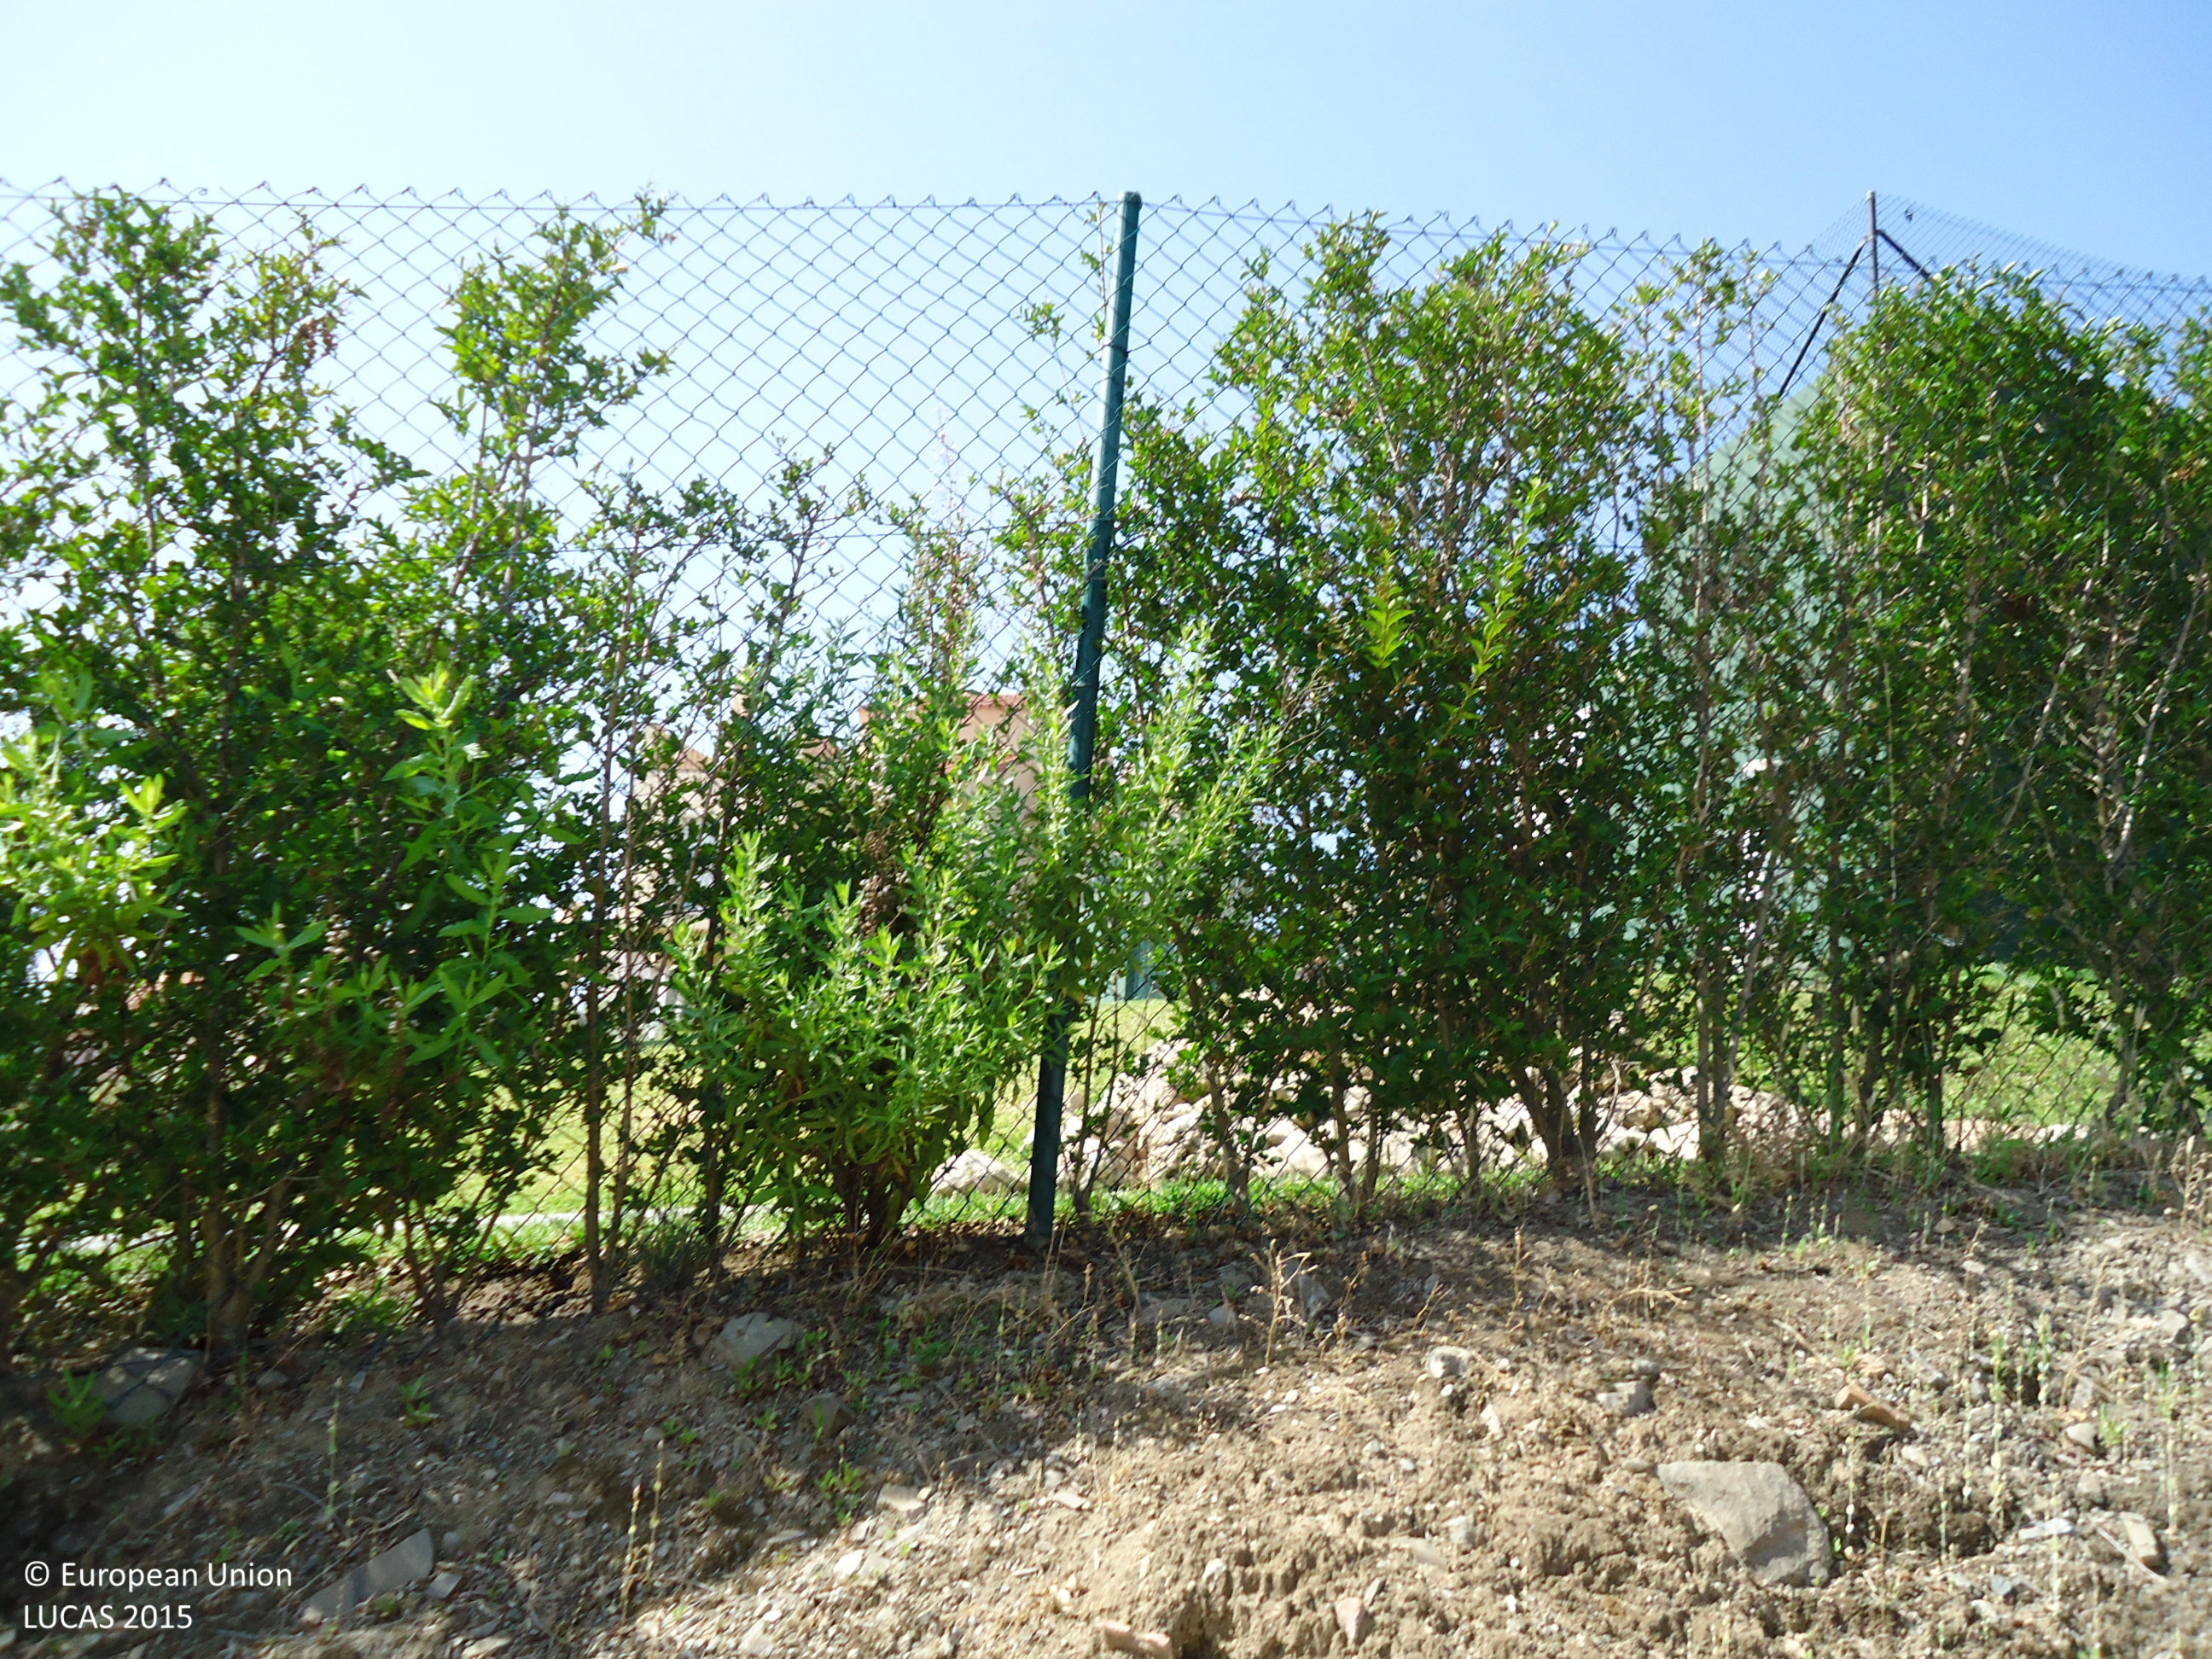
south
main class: Grassland
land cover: Grassland with sparse tree/shrub cover
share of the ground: > 75 %
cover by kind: herbaceous plants 95 %, broadleaved forest trees 5 %
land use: Residential
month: July
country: ES
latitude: 36.5039
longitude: -4.7157
